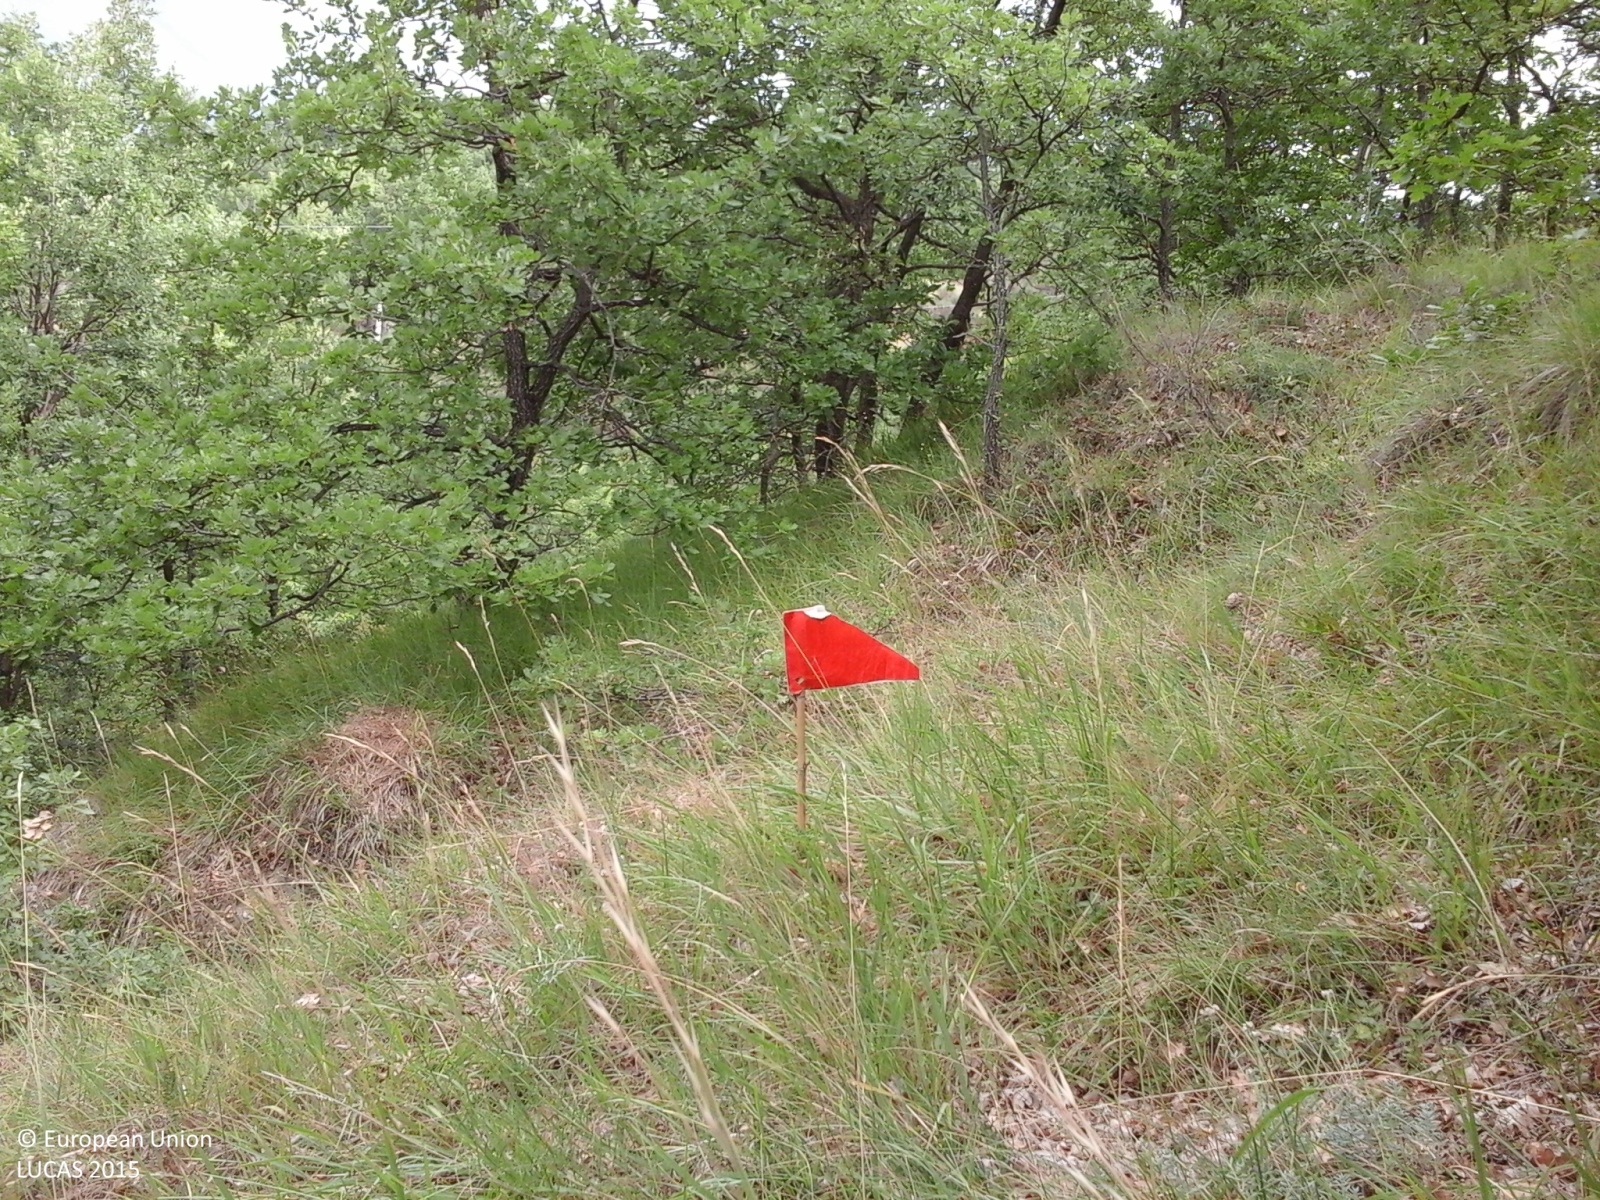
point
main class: Woodland
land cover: Broadleaved woodland
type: thermophilous deciduous forest
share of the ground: > 75 %
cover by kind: broadleaved forest trees 75 %, shrubs 20 %, herbaceous plants 5 %
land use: Semi-natural and natural areas not in use
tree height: > 5 m
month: August
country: IT
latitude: 41.7985
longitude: 14.4019
